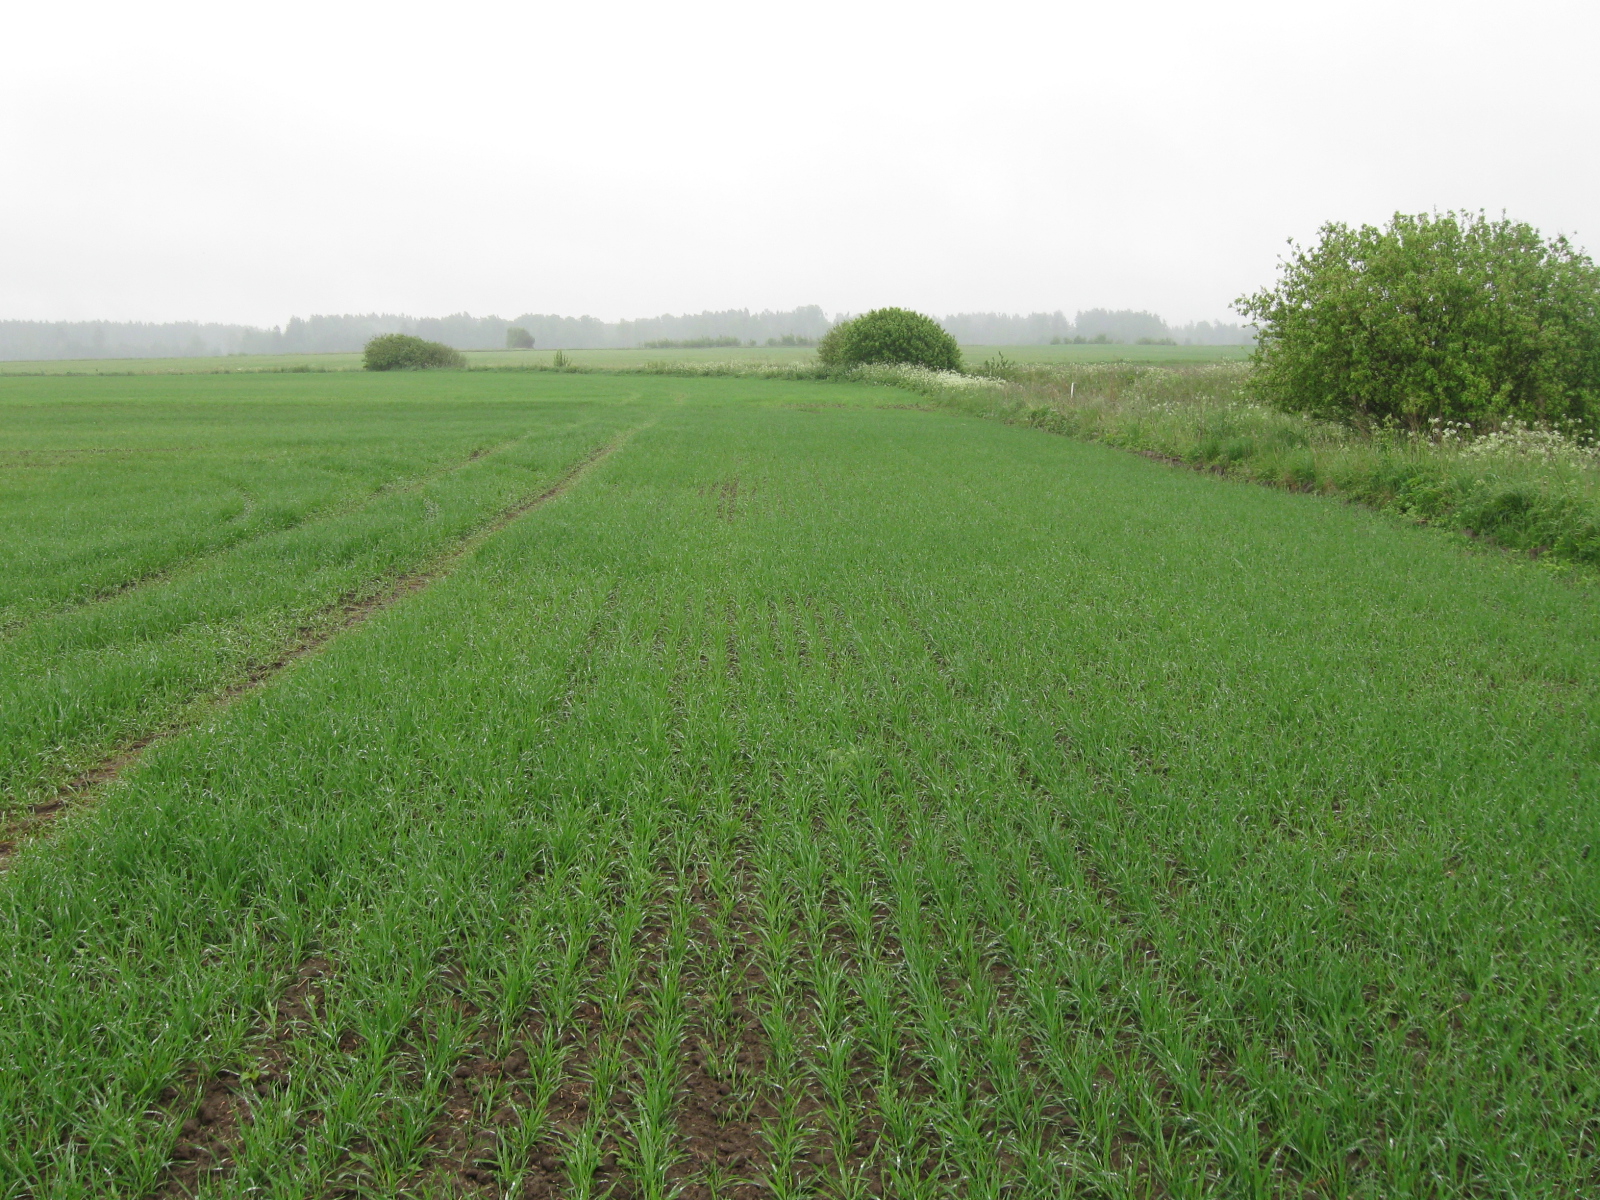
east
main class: Cropland
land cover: Common wheat
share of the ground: > 75 %
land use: Agriculture (excluding fallow land and kitchen gardens)
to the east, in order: Common wheat; Spontaneously vegetated surfaces; Ditches and canals; Spontaneously vegetated surfaces; Maize; Common wheat
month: May
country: LT
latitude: 55.0052
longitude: 22.7149
